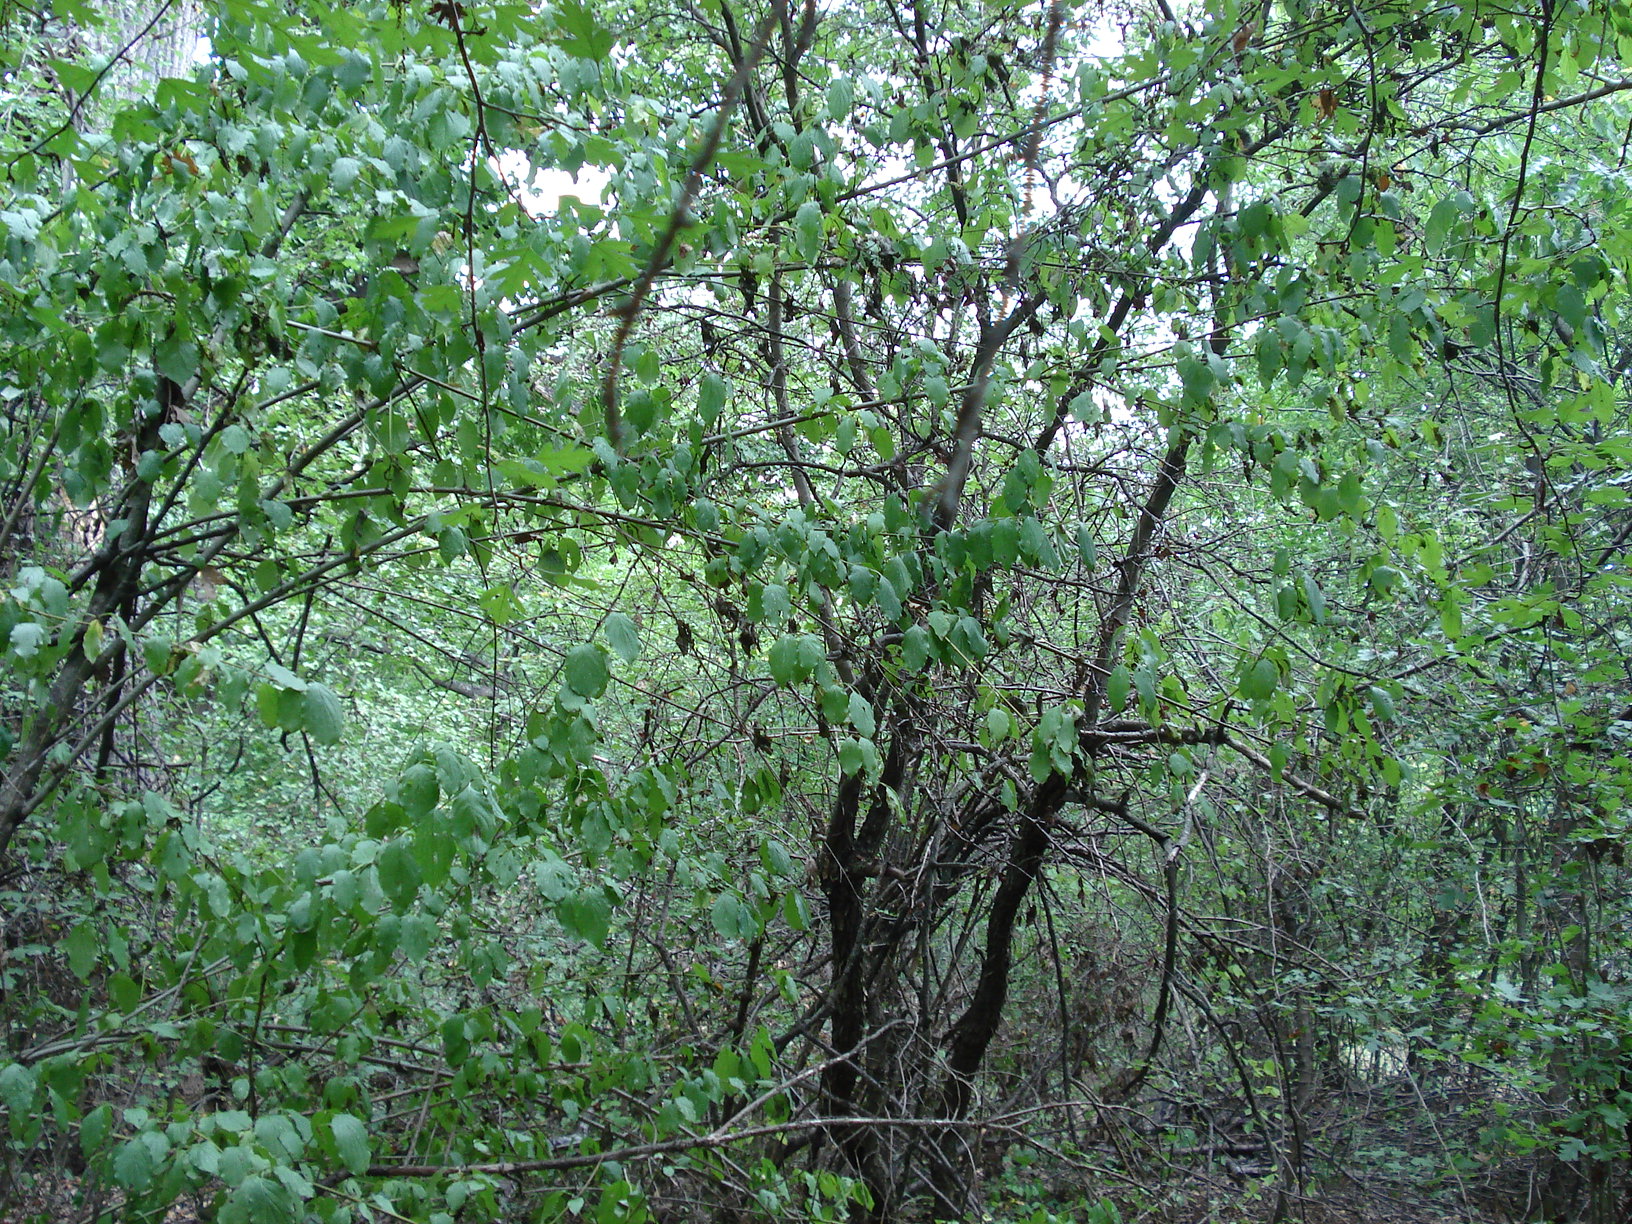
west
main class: Woodland
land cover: Broadleaved woodland
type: mesophytic deciduous forest
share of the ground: > 75 %
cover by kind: broadleaved forest trees 85 %, herbaceous plants 10 %, shrubs 5 %
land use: Forestry
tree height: > 5 m
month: September
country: BG
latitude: 43.0456
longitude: 25.7583
